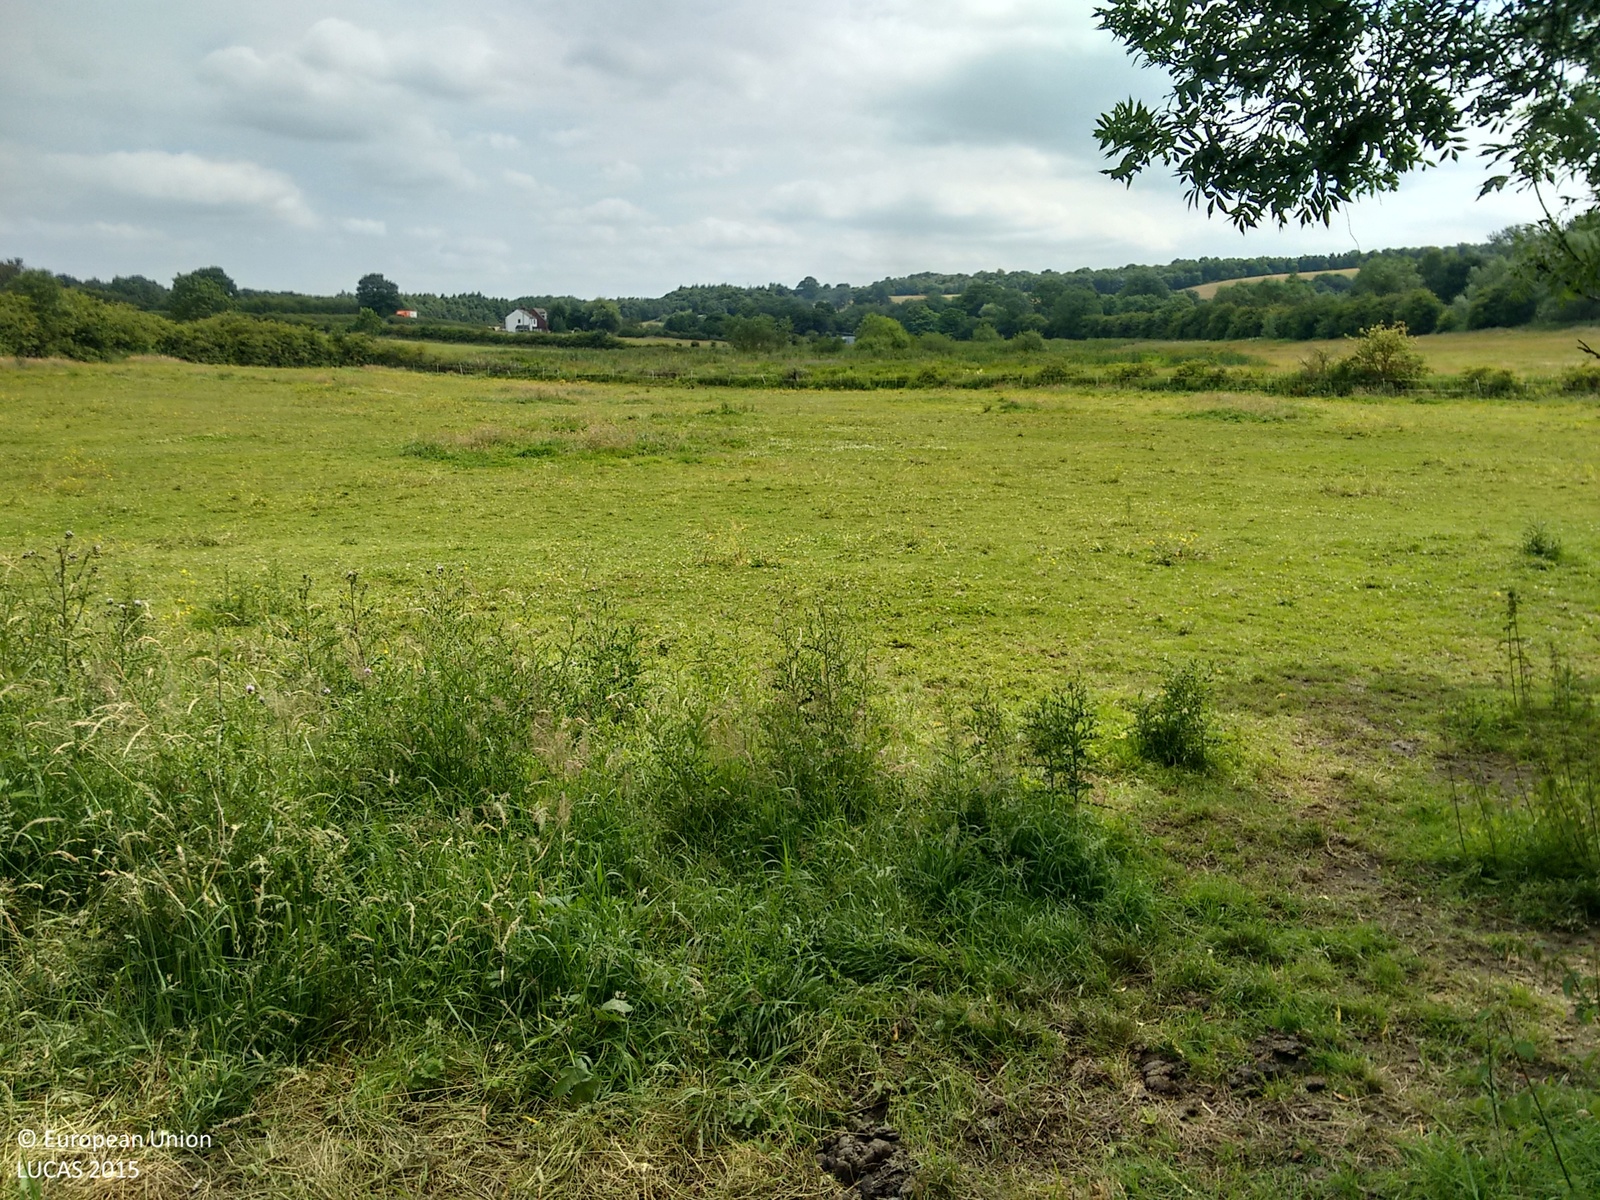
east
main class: Grassland
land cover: Grassland without tree/shrub cover
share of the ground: > 75 %
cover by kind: herbaceous plants 100 %
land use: Agriculture (excluding fallow land and kitchen gardens)
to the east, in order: Grassland without tree/shrub cover; Fences; Managed hedges; Rivers and streams; Inland marshes; Ditches and canals; Managed hedges; Grassland without tree/shrub cover; Managed hedges; Grassland without tree/shrub cover
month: July
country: GB
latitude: 53.0581
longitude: -1.4341
